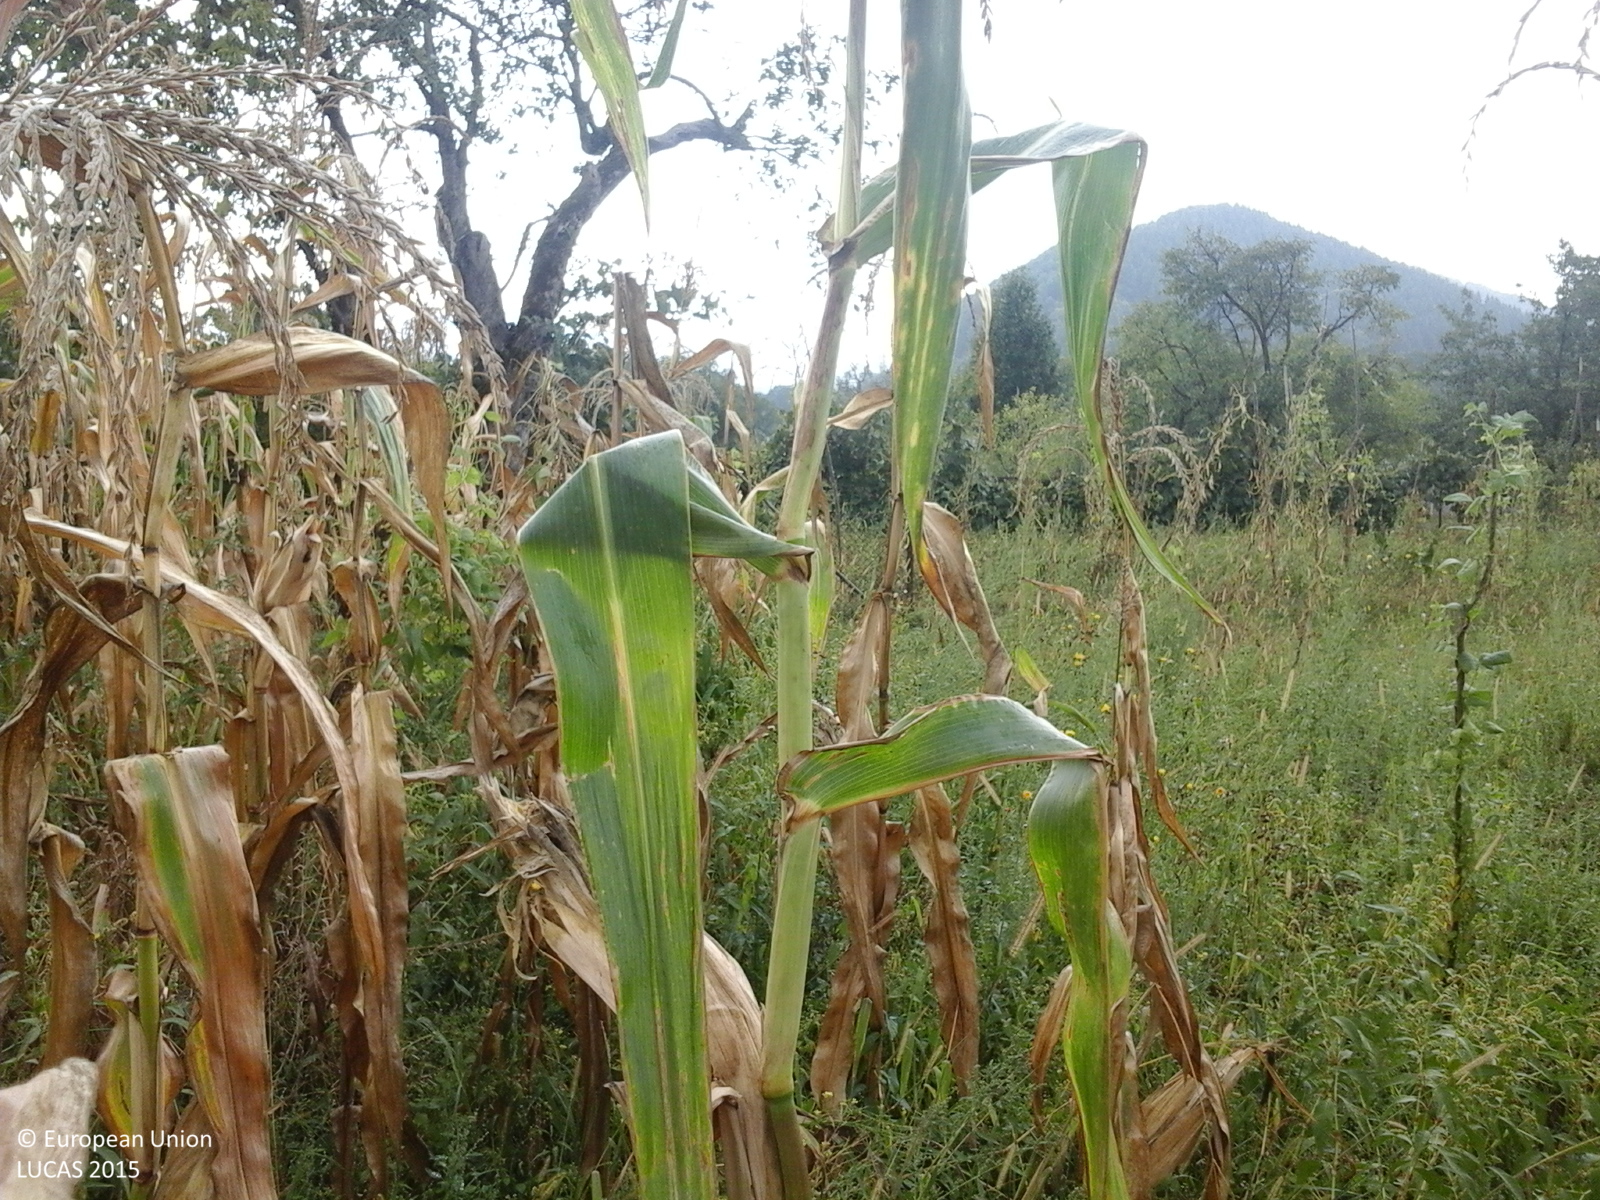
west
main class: Cropland
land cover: Maize
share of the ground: 50 - 75 %
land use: Agriculture (excluding fallow land and kitchen gardens)
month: September
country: RO
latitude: 47.8822
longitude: 23.9243
